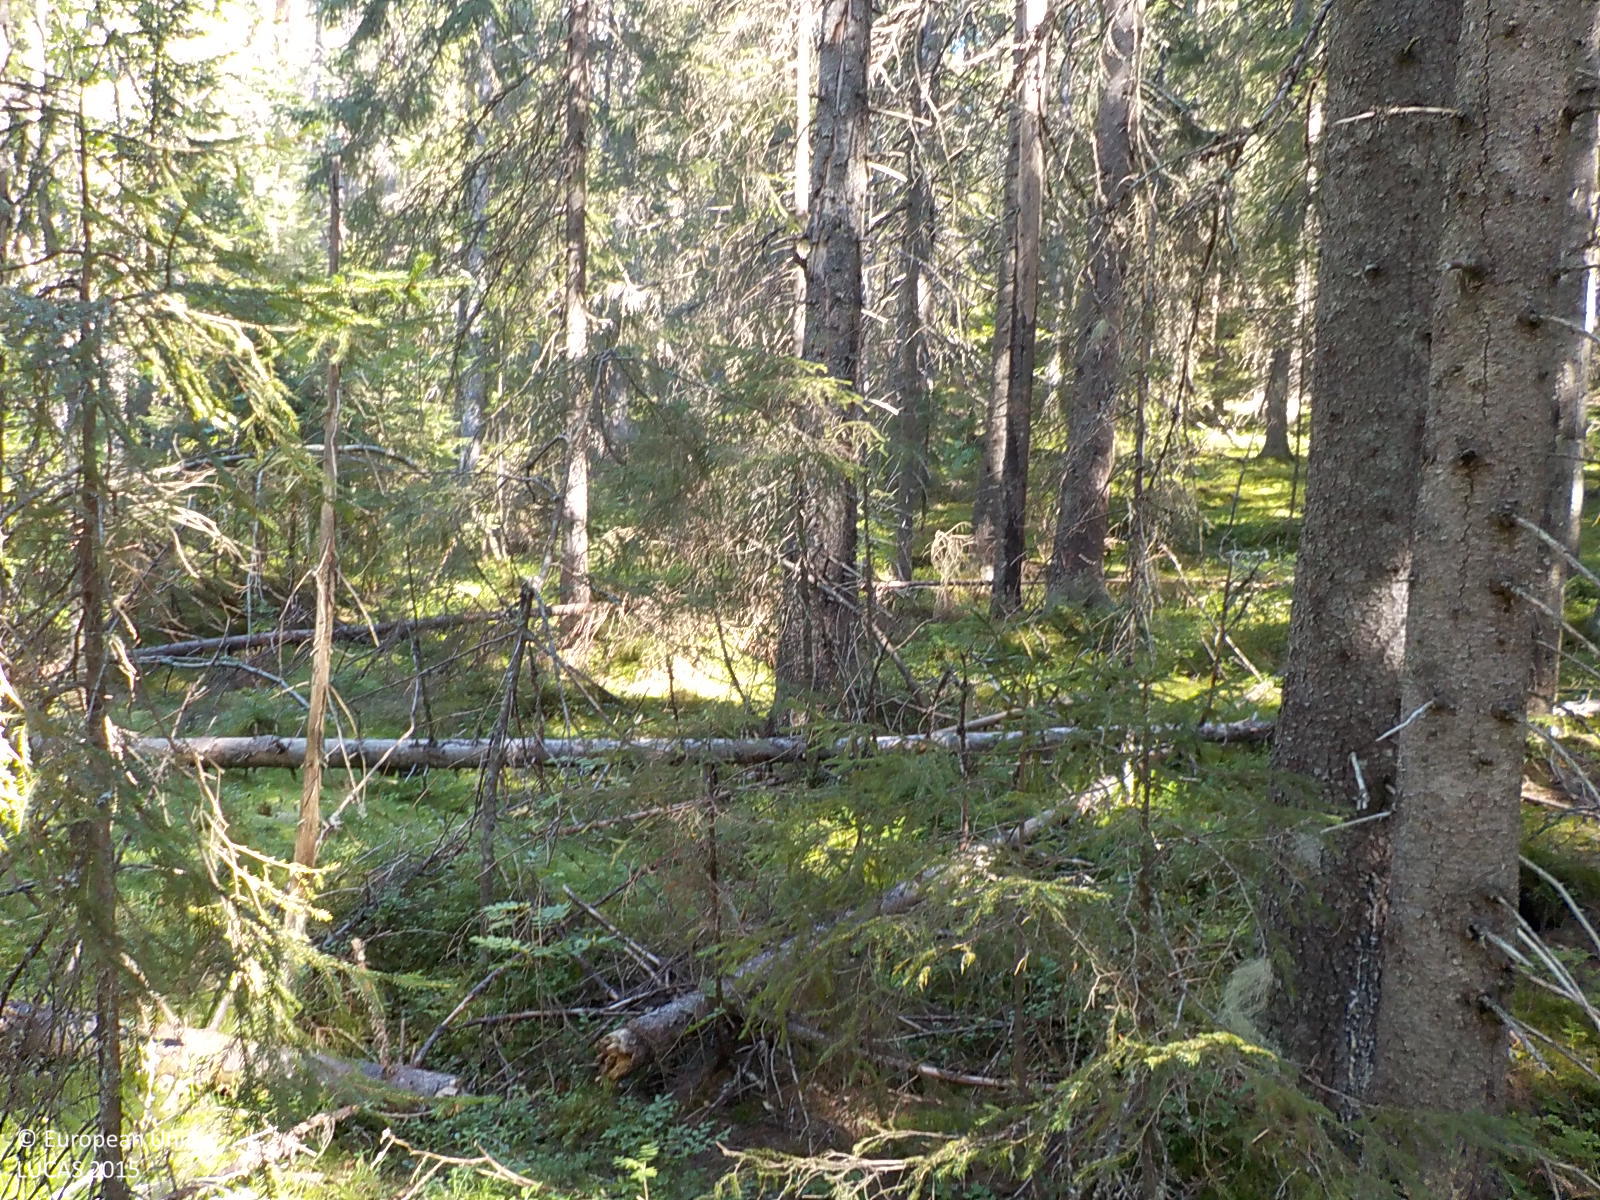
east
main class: Woodland
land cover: Spruce dominated coniferous woodland
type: boreal forest
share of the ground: > 75 %
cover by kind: coniferous forest trees 75 %, shrubs 15 %, lichens and mosses 10 %
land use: Forestry
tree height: > 5 m
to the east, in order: Spruce dominated coniferous woodland; Pine dominated coniferous woodland; Rocks and stones; Pine dominated mixed woodland
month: August
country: SE
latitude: 63.3631
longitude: 18.6341
